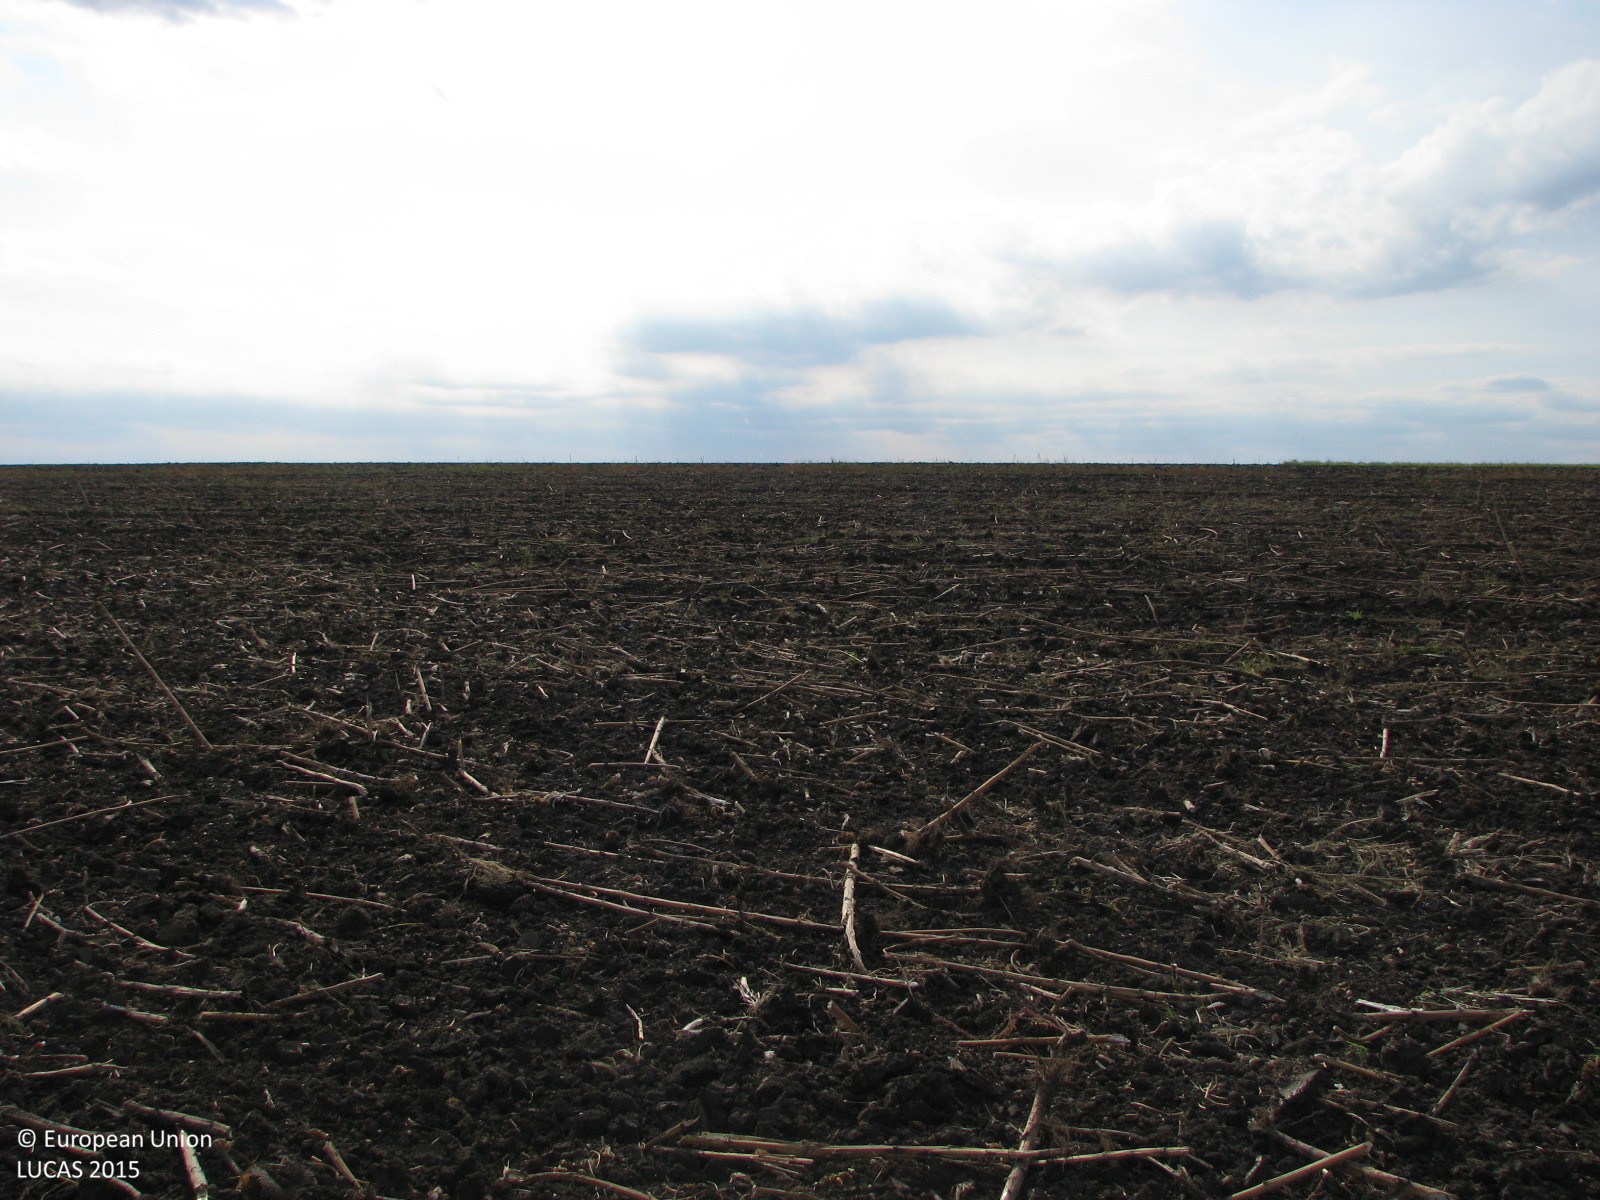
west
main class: Cropland
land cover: Sunflower
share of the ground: < 10 %
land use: Agriculture (excluding fallow land and kitchen gardens)
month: September
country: BG
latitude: 42.3222
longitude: 26.0358
